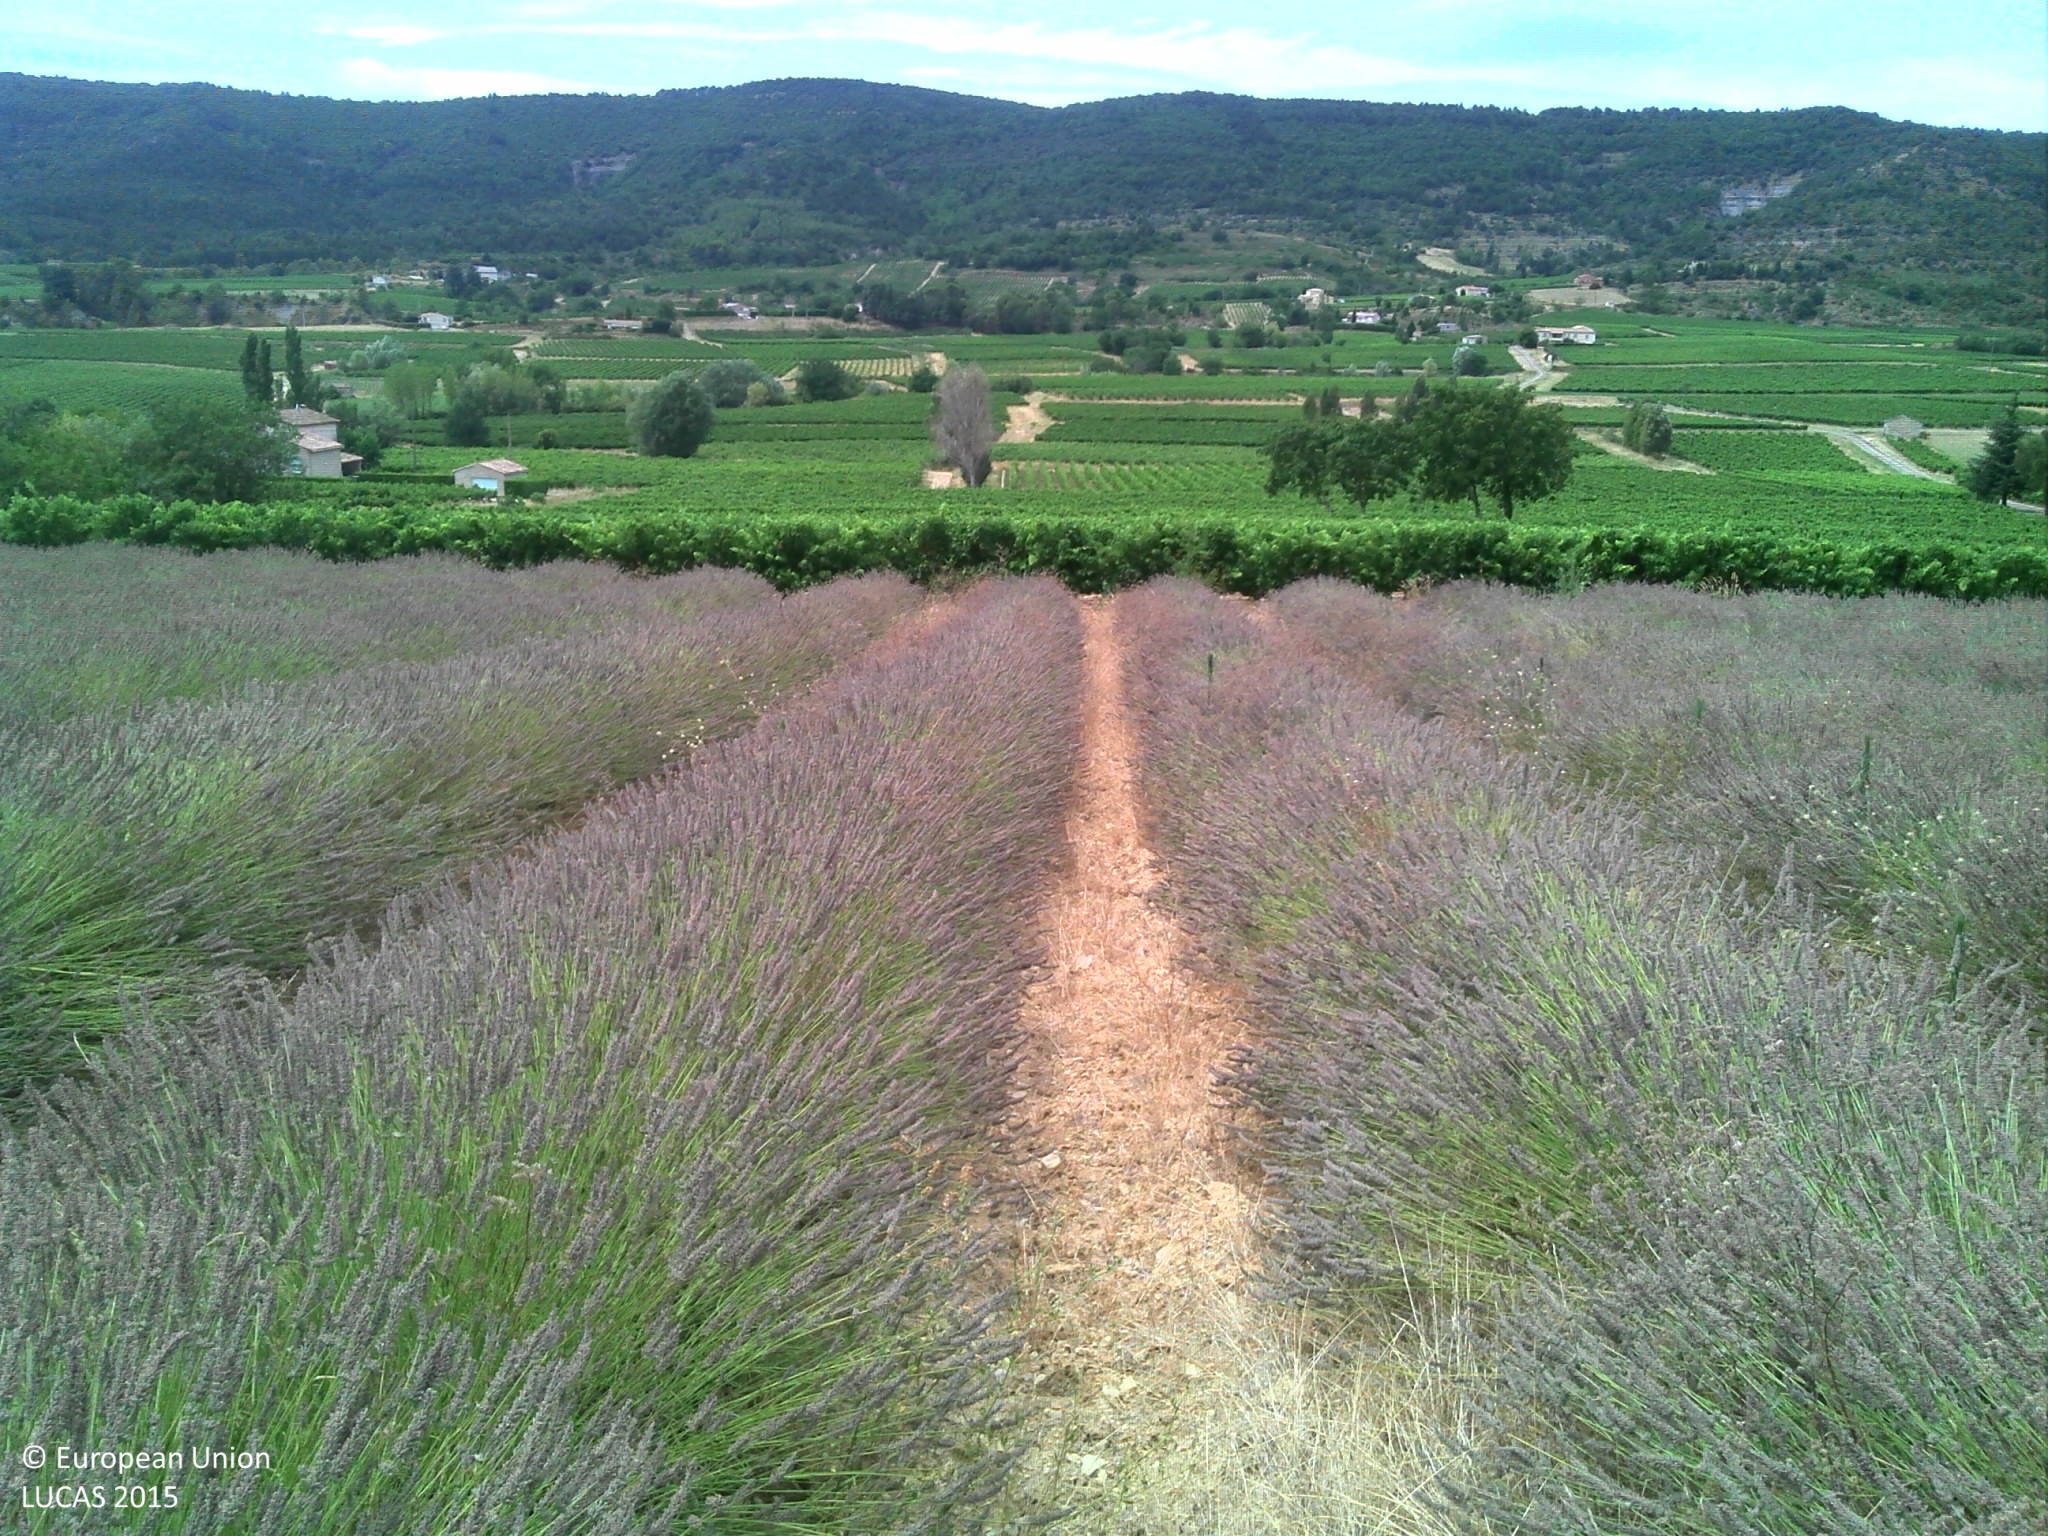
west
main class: Cropland
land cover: Floriculture and ornamental plants
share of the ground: > 75 %
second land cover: Spontaneously vegetated surfaces
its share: 50 - 75 %
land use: Agriculture (excluding fallow land and kitchen gardens)
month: July
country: FR
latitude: 44.5164
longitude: 4.5845
